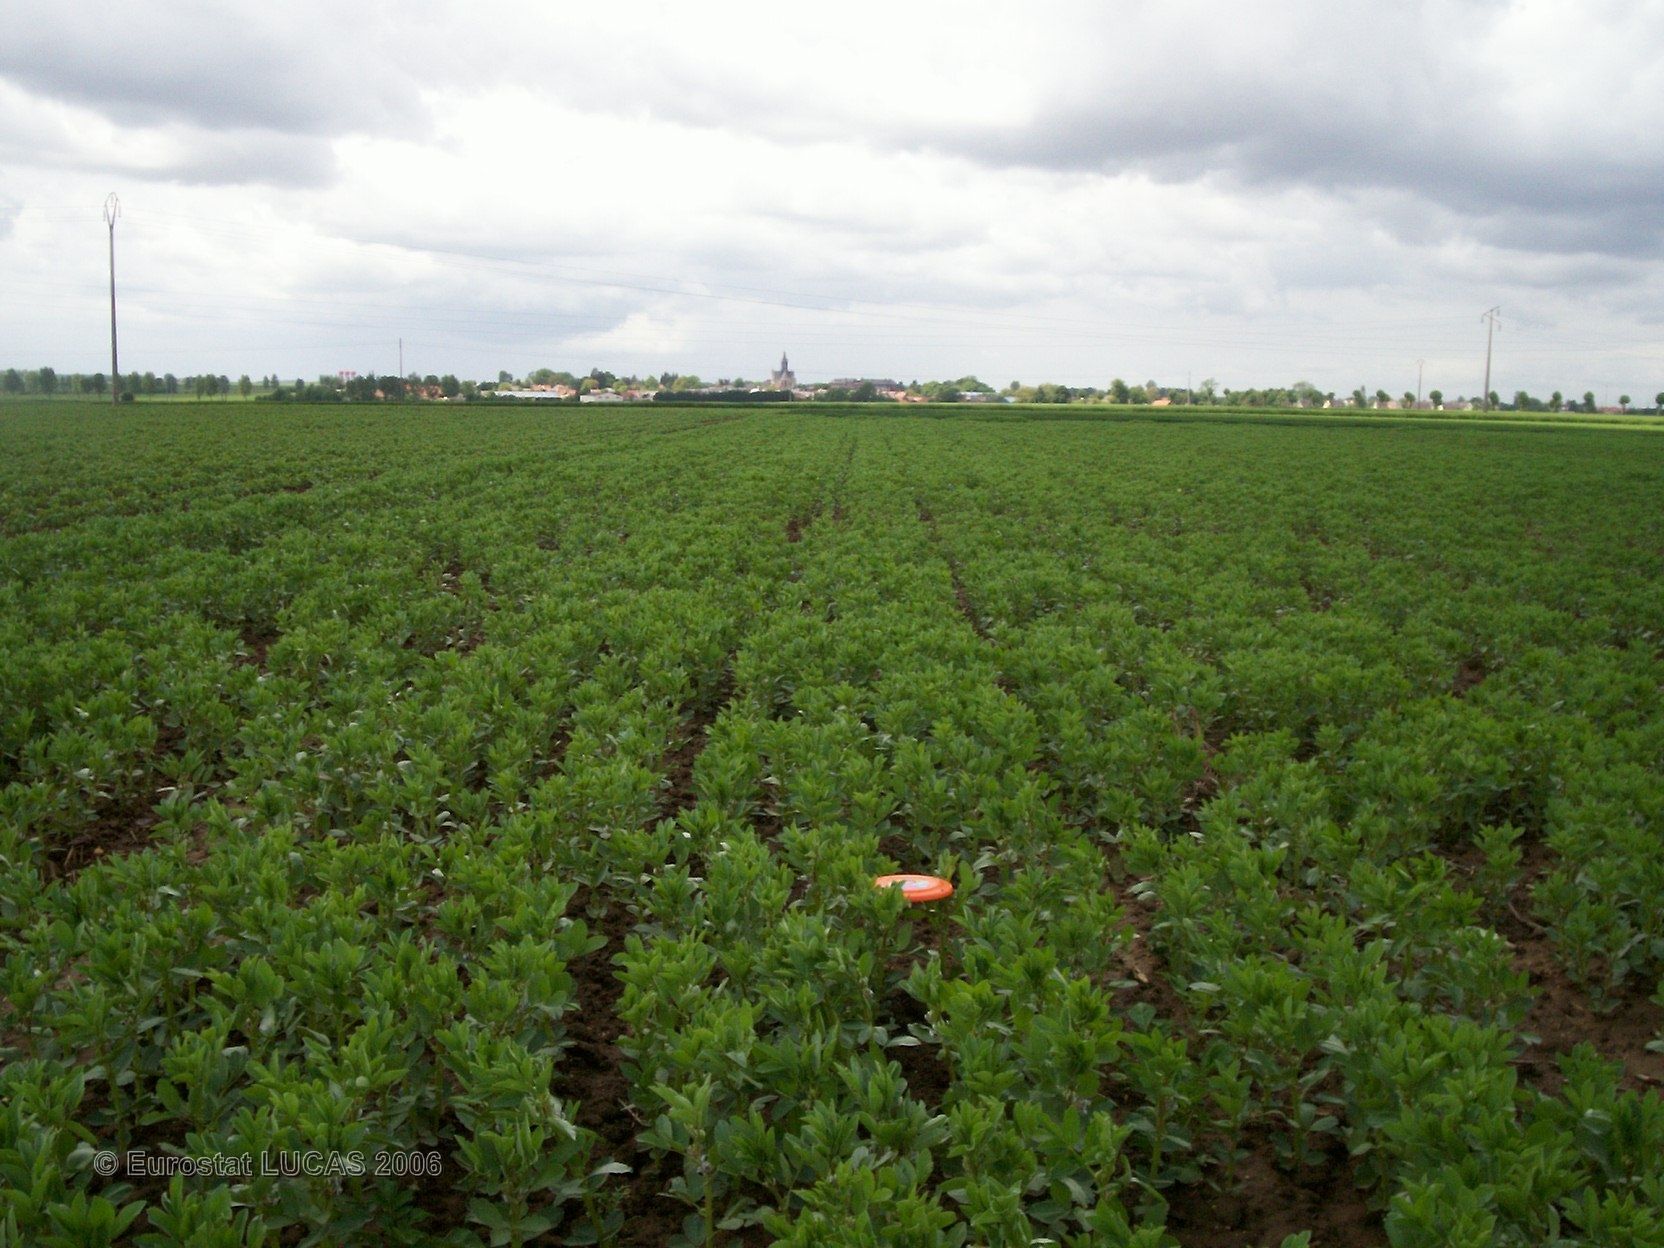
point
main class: Cropland
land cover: Dry pulses
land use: Agriculture (excluding fallow land and kitchen gardens)
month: May
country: FR
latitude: 49.8410
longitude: 2.6885
